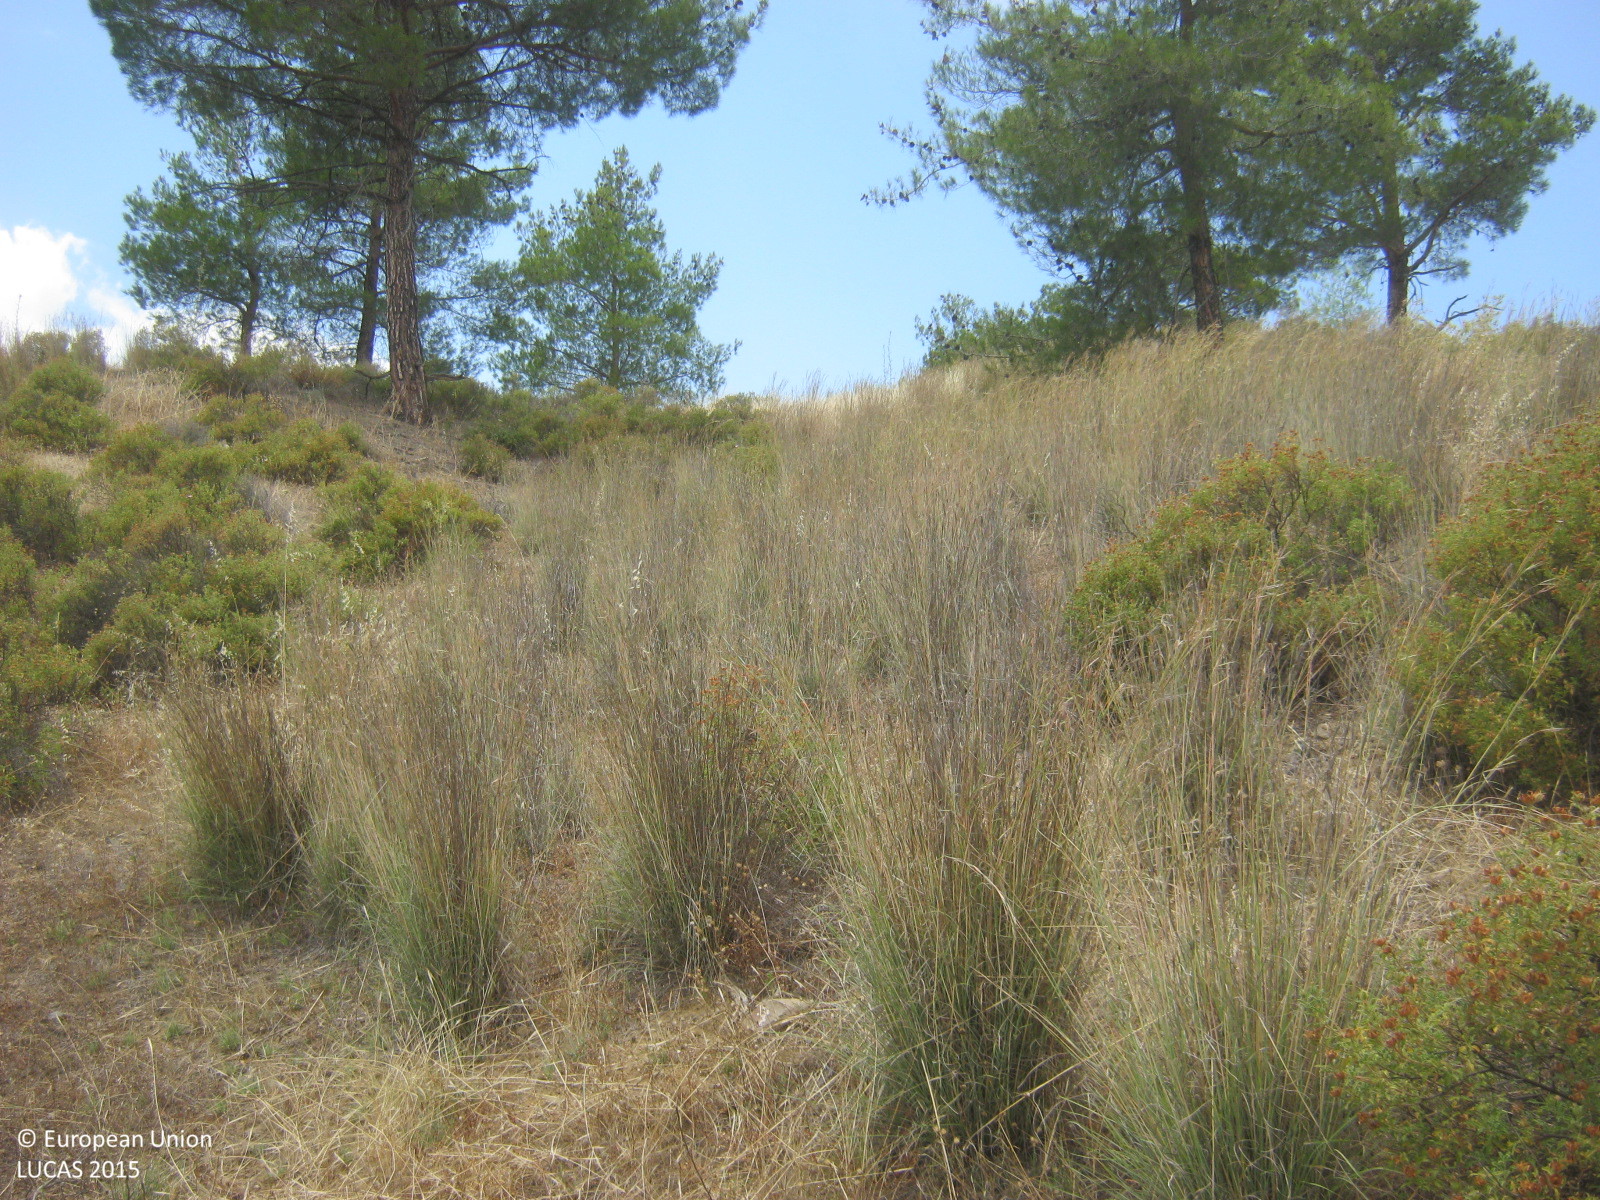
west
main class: Woodland
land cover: Pine dominated coniferous woodland
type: coniferous forest of the mediterranean region
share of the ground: 10 - 25 %
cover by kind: shrubs 40 %, herbaceous plants 30 %, coniferous forest trees 25 %, unconsolidated bare surface 5 %
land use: Forestry
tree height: > 5 m
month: June
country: CY
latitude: 35.0505
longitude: 32.8762
